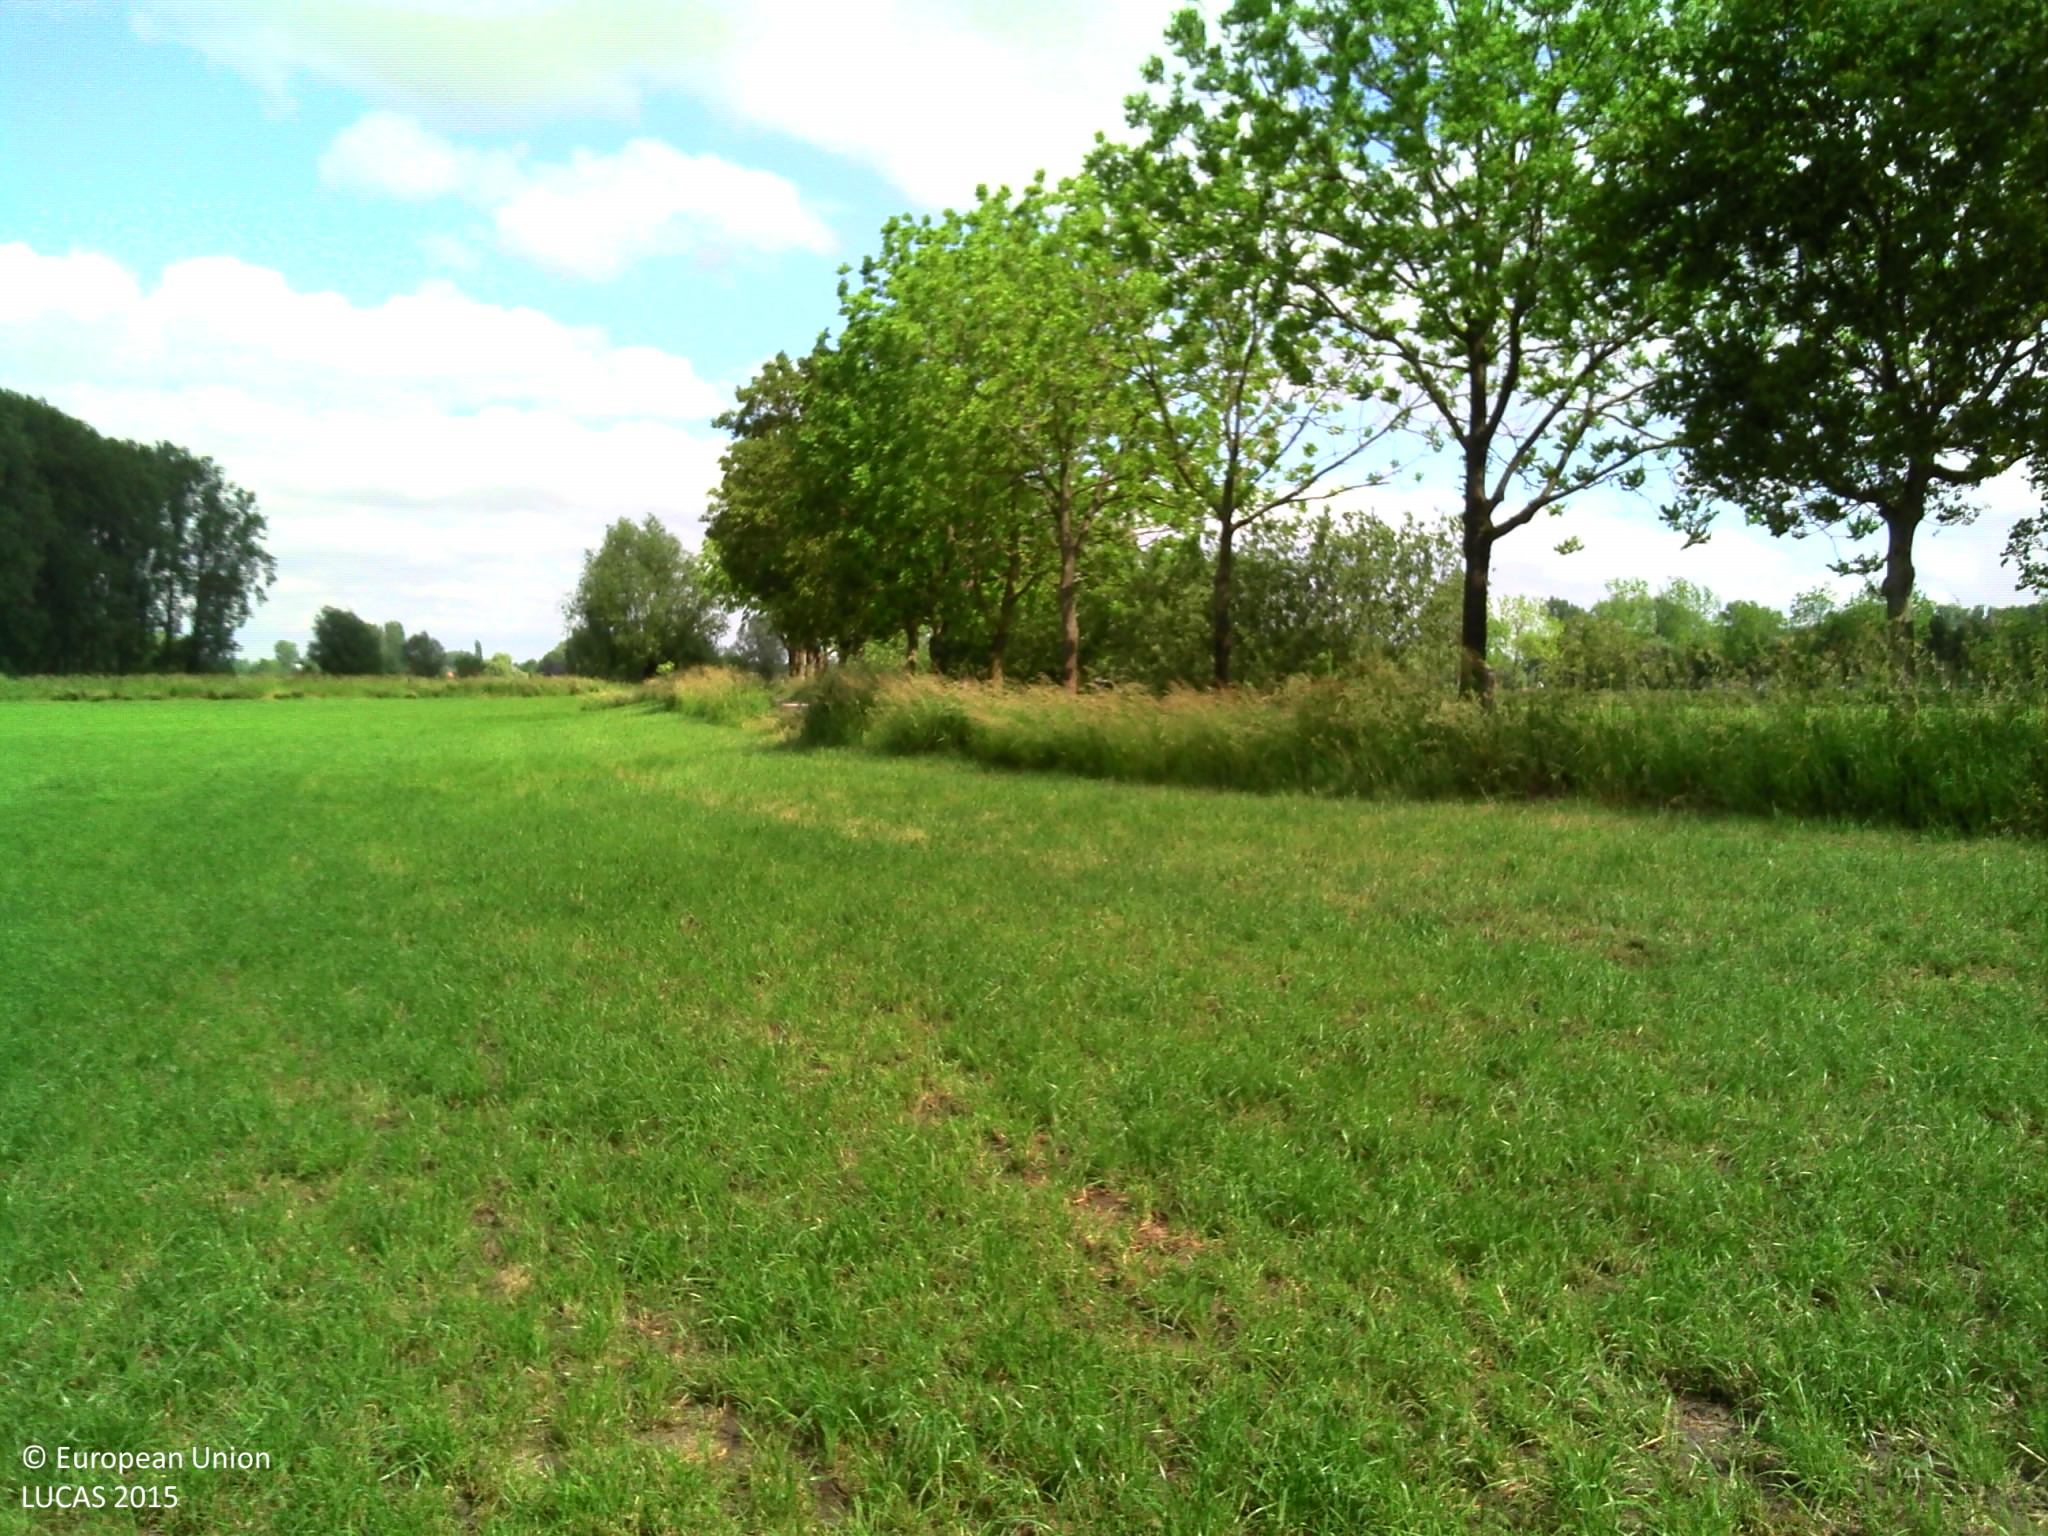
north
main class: Cropland
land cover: Temporary grasslands
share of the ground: > 75 %
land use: Agriculture (excluding fallow land and kitchen gardens)
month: June
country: BE
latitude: 50.9651
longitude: 3.6851
